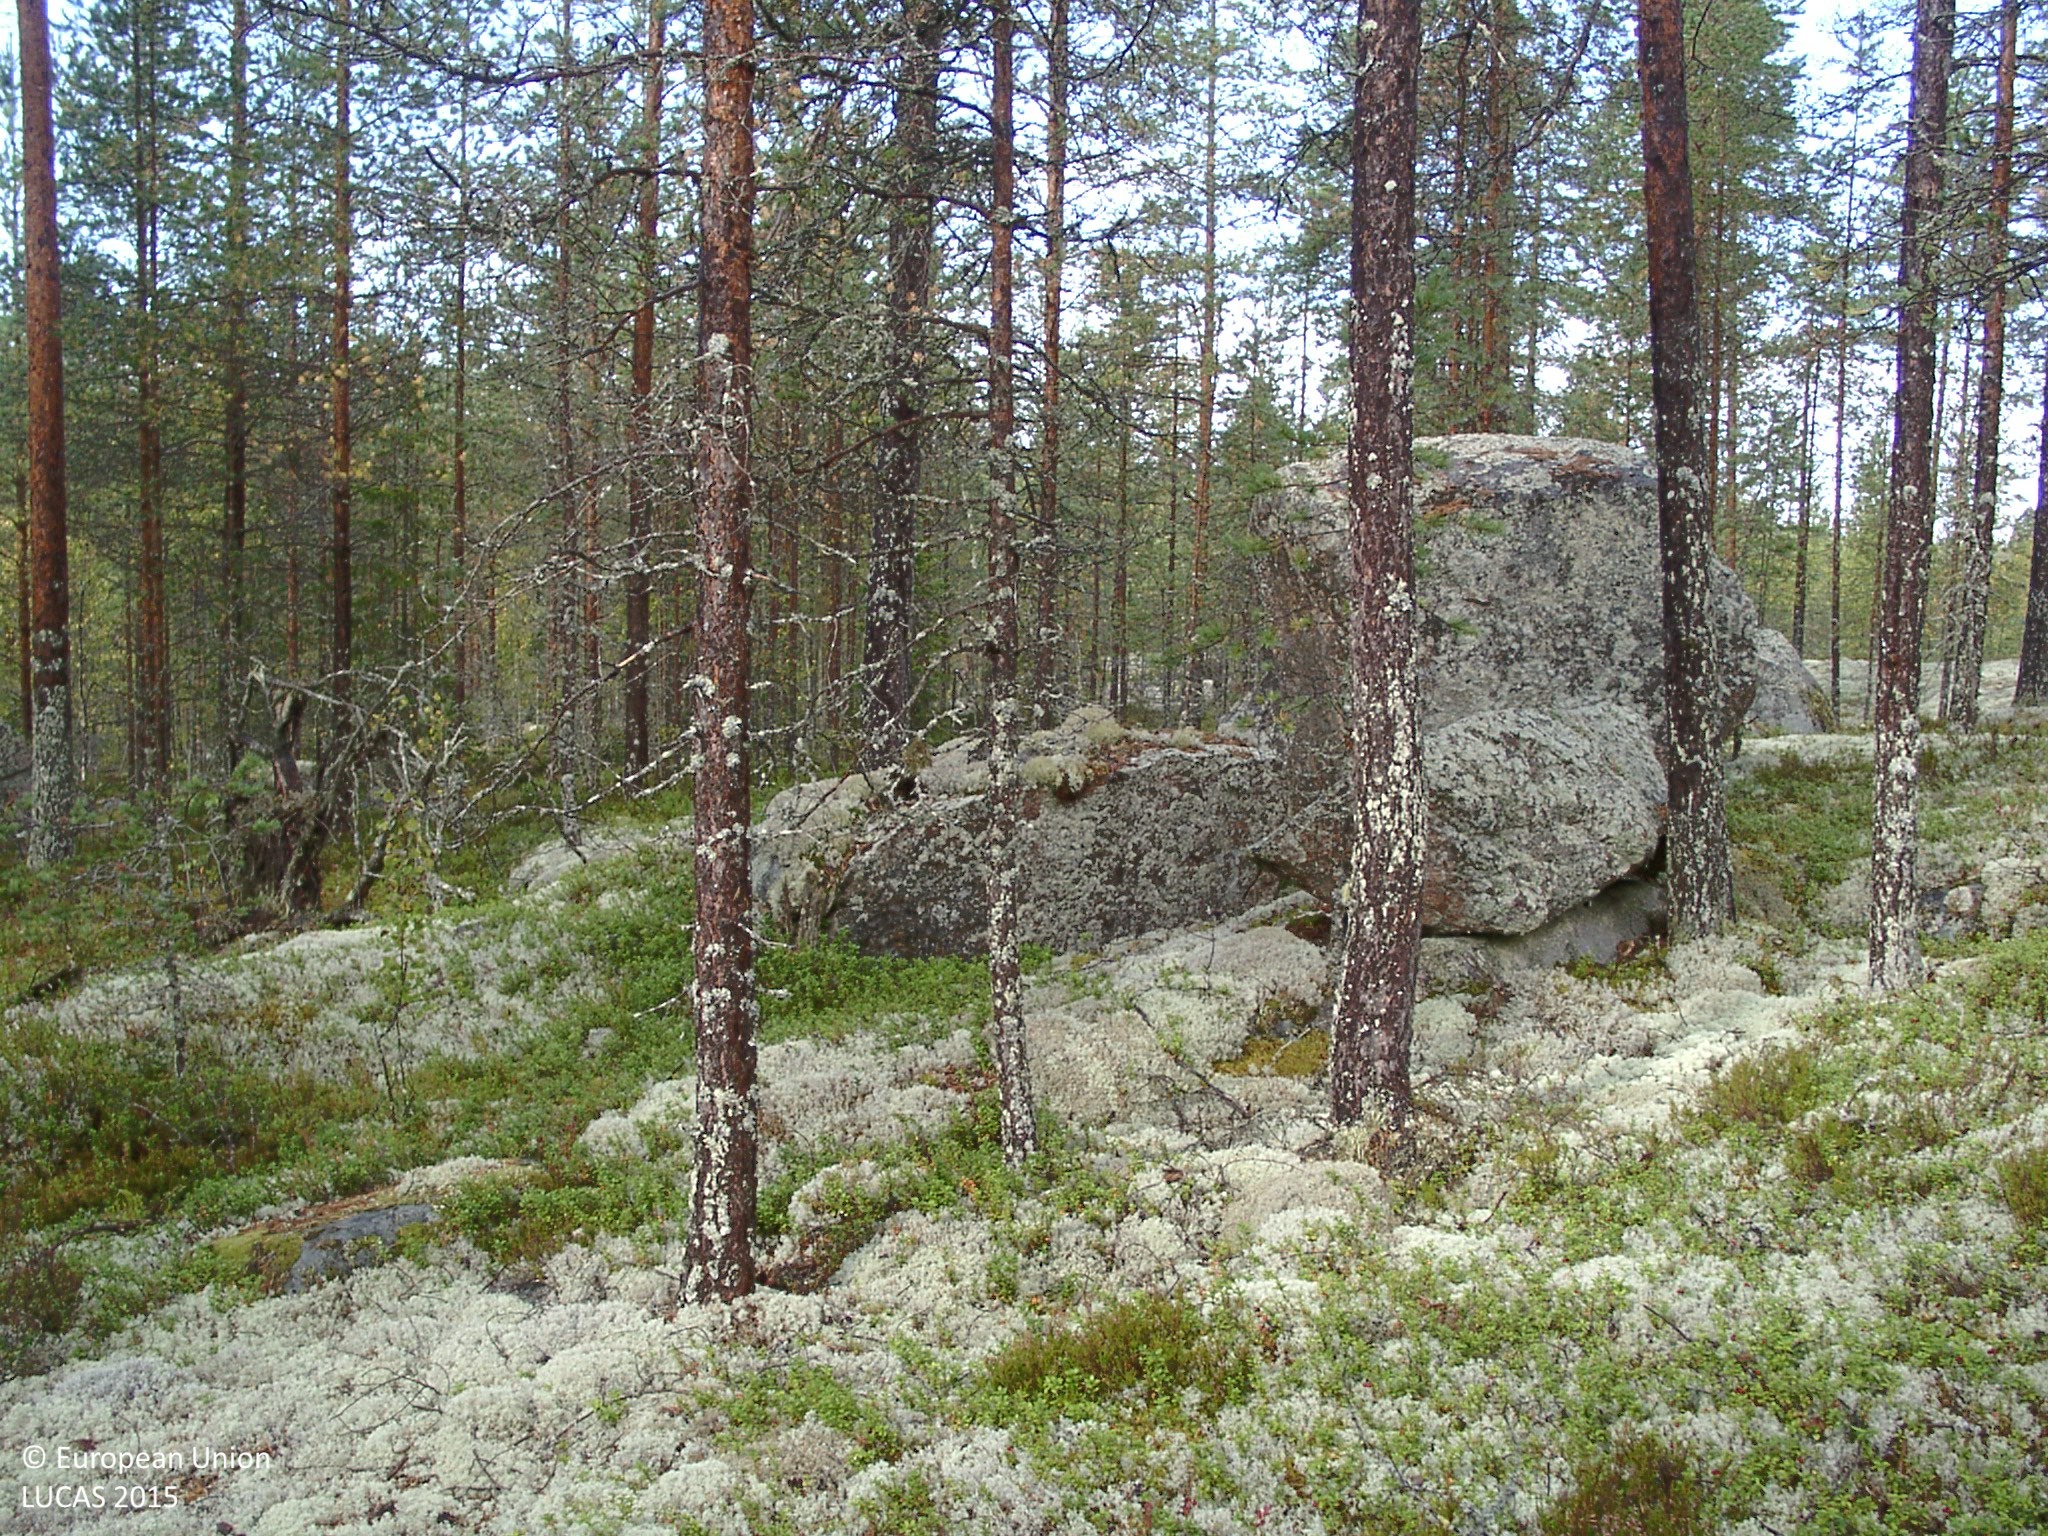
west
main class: Woodland
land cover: Pine dominated coniferous woodland
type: boreal forest
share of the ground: 25 - 50 %
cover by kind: coniferous forest trees 35 %, lichens and mosses 35 %, shrubs 25 %, unconsolidated bare surface 5 %
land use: Forestry
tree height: > 5 m
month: September
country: FI
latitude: 62.7475
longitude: 24.9142
